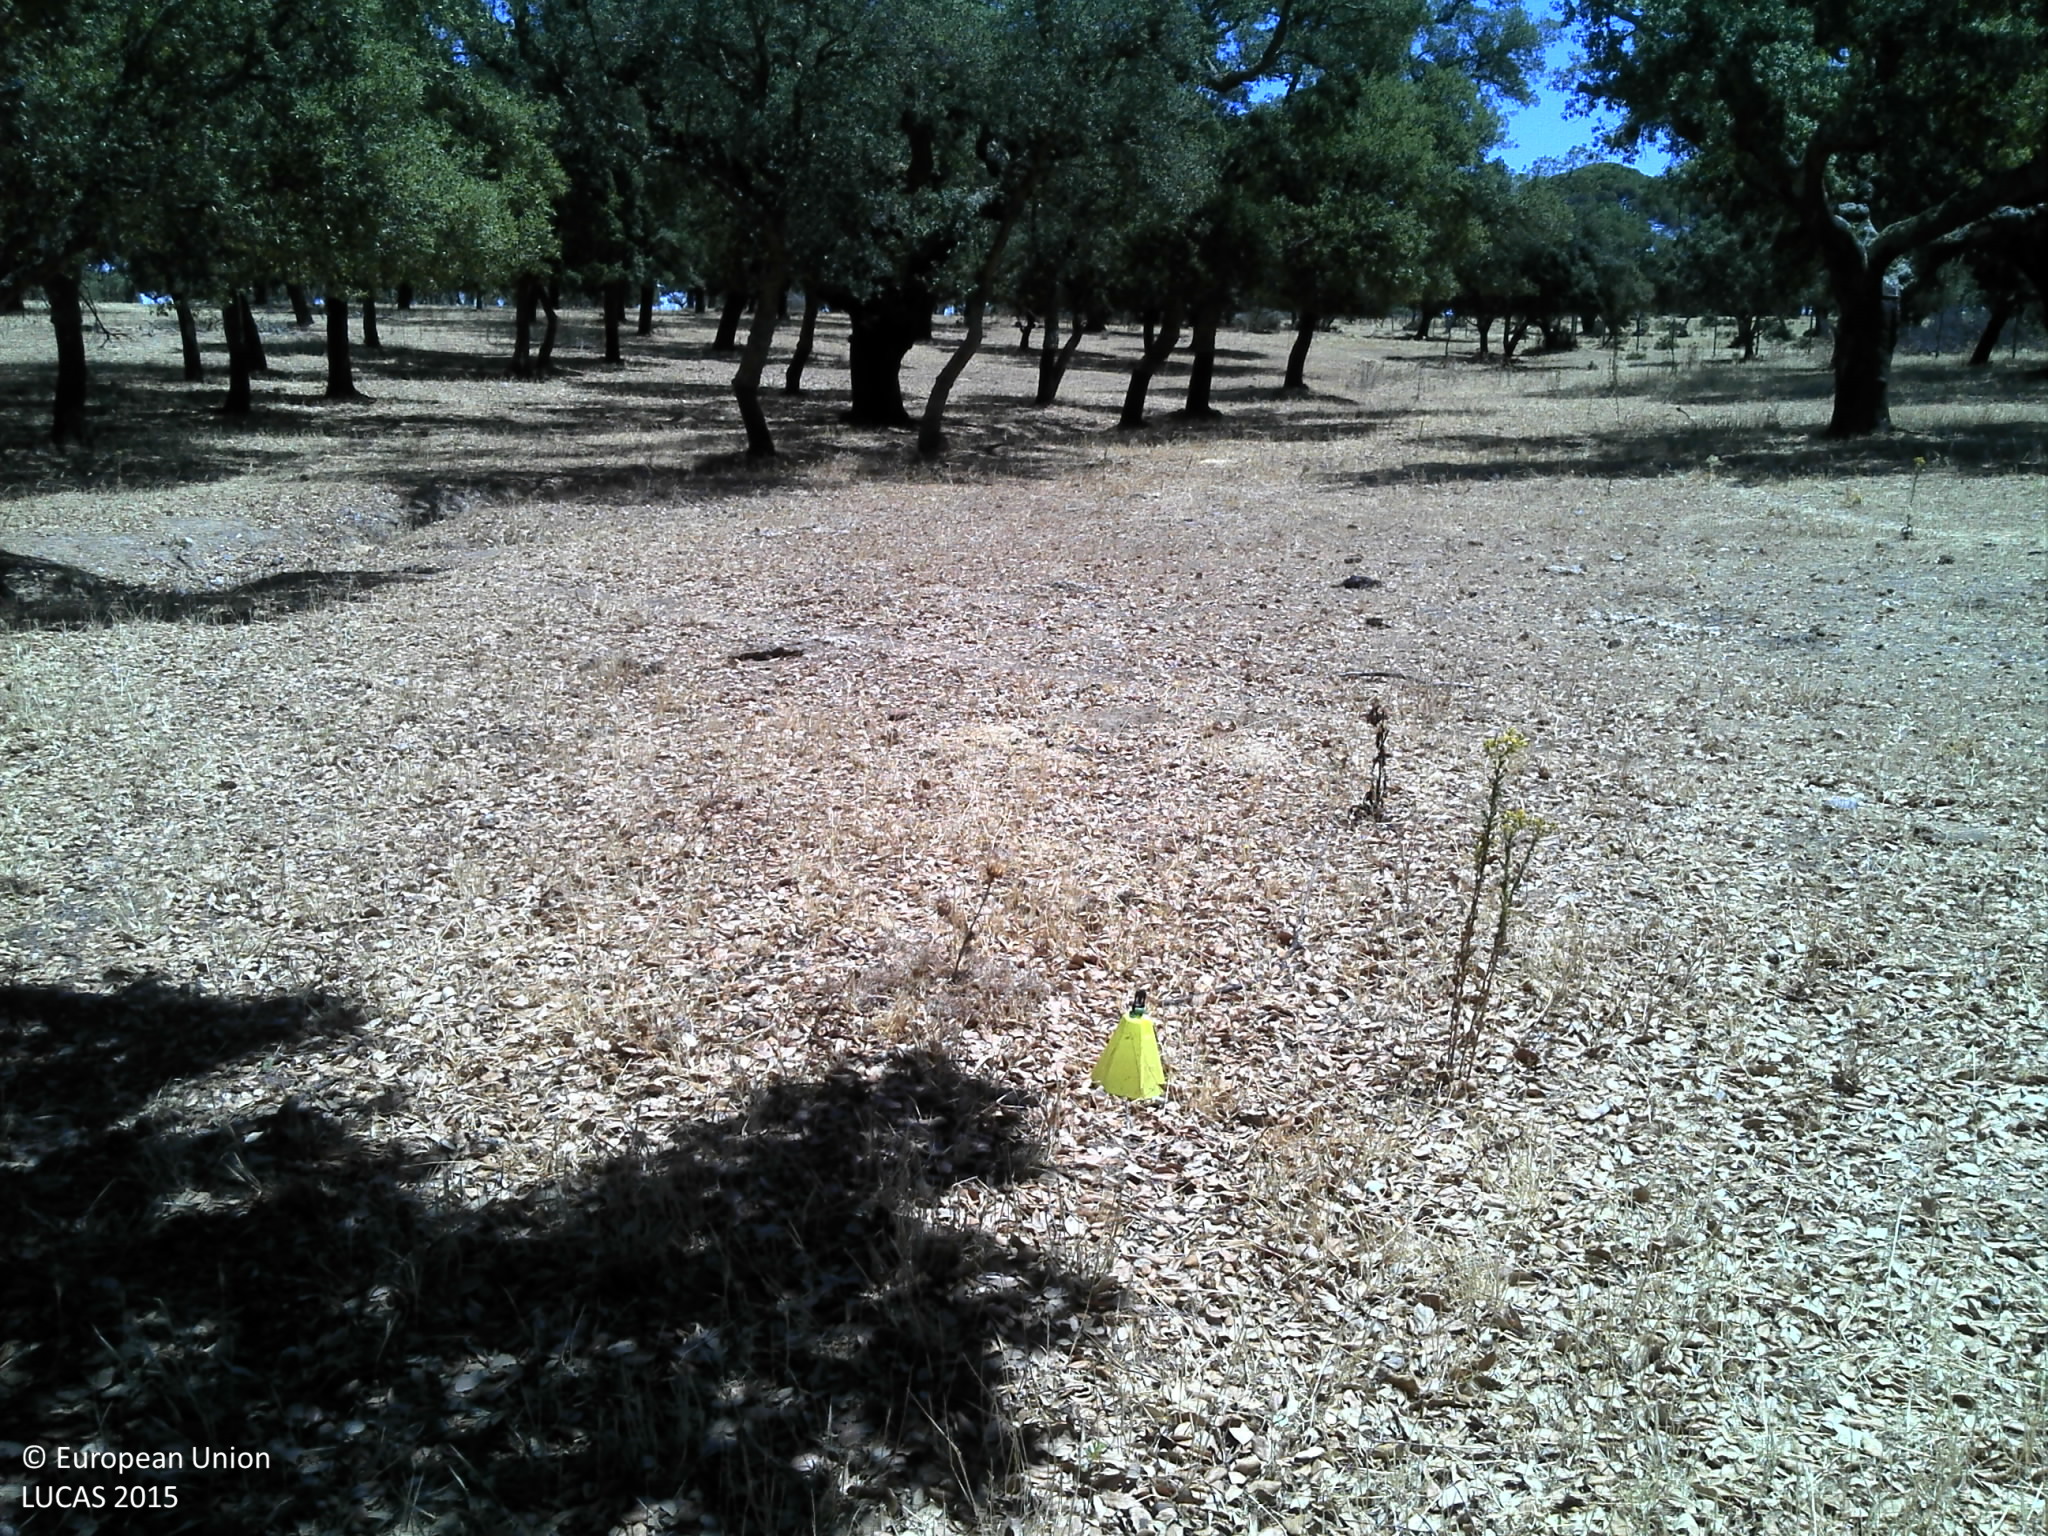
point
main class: Woodland
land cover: Broadleaved woodland
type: broadleaved evergreen forest
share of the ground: 50 - 75 %
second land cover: Grassland without tree/shrub cover
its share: 10 - 25 %
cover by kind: broadleaved forest trees 50 %, unconsolidated bare surface 30 %, herbaceous plants 20 %
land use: Forestry
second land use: Agriculture (excluding fallow land and kitchen gardens)
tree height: > 5 m
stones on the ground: < 10 %
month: July
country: PT
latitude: 38.8578
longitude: -7.5405
